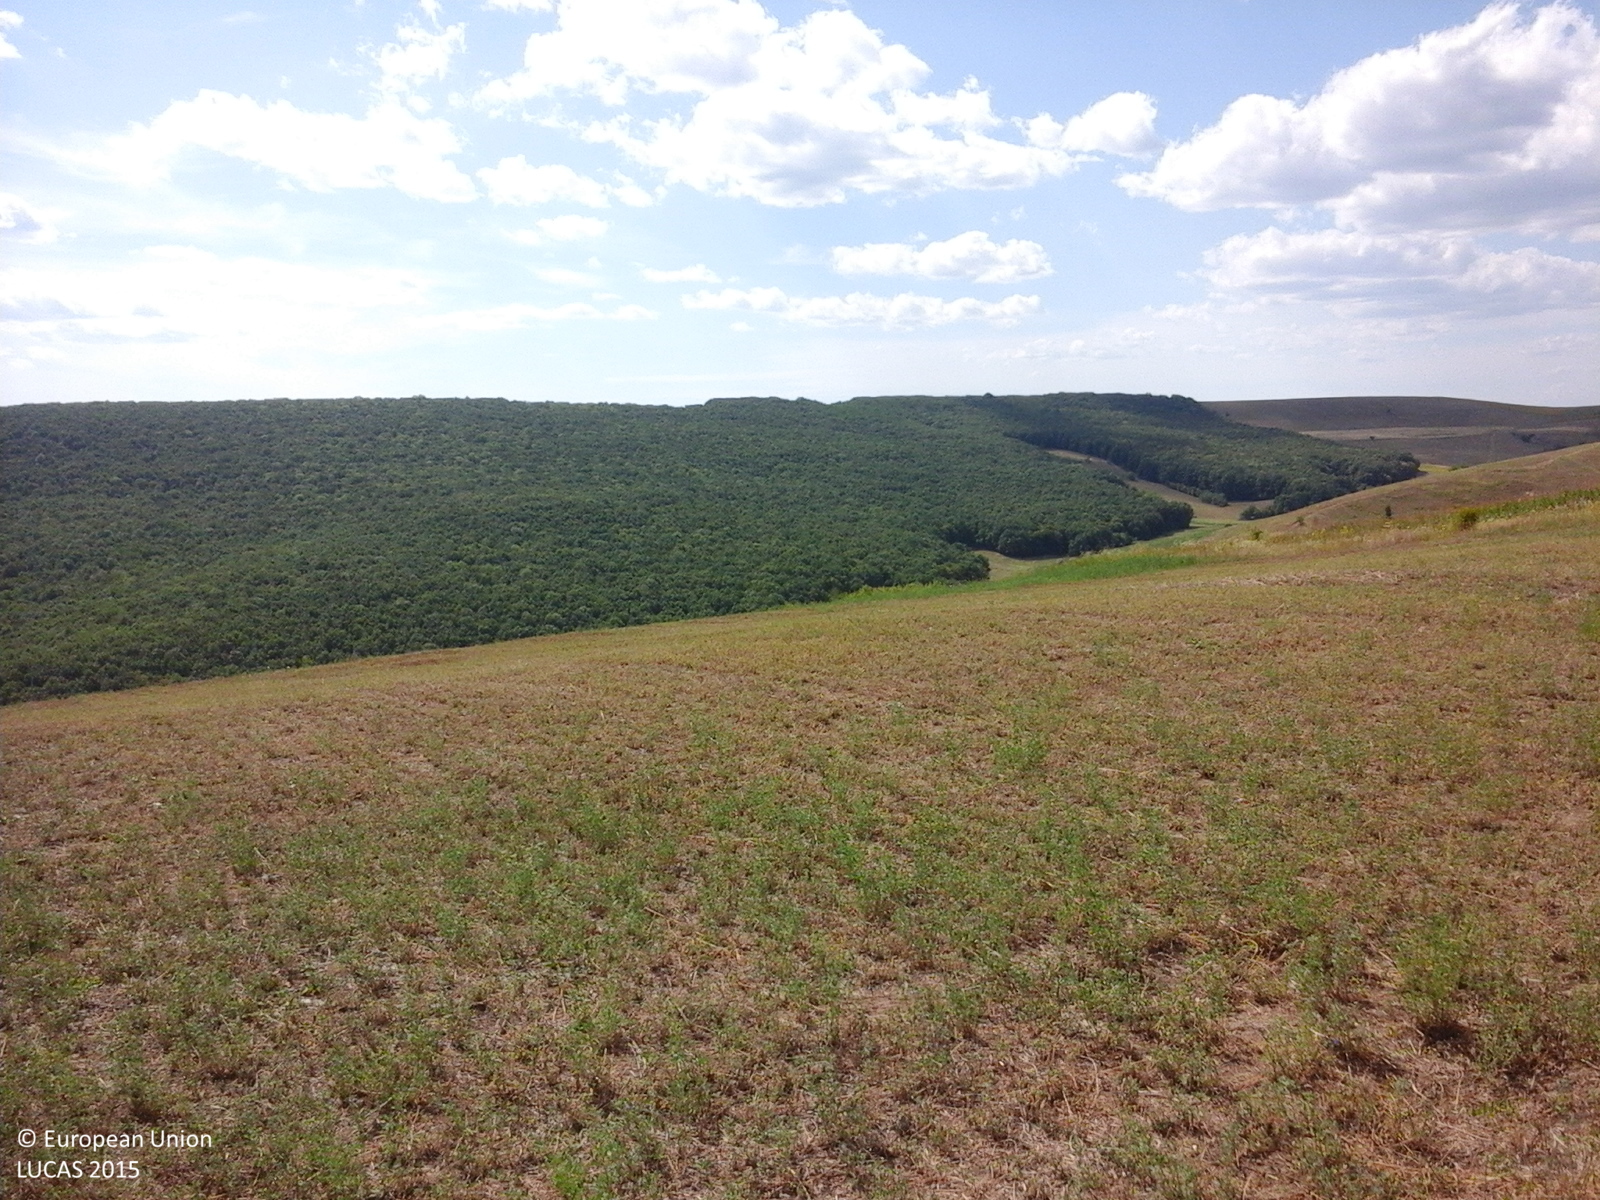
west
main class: Cropland
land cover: Lucerne
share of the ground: 25 - 50 %
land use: Agriculture (excluding fallow land and kitchen gardens)
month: July
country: RO
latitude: 46.3682
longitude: 27.3816
